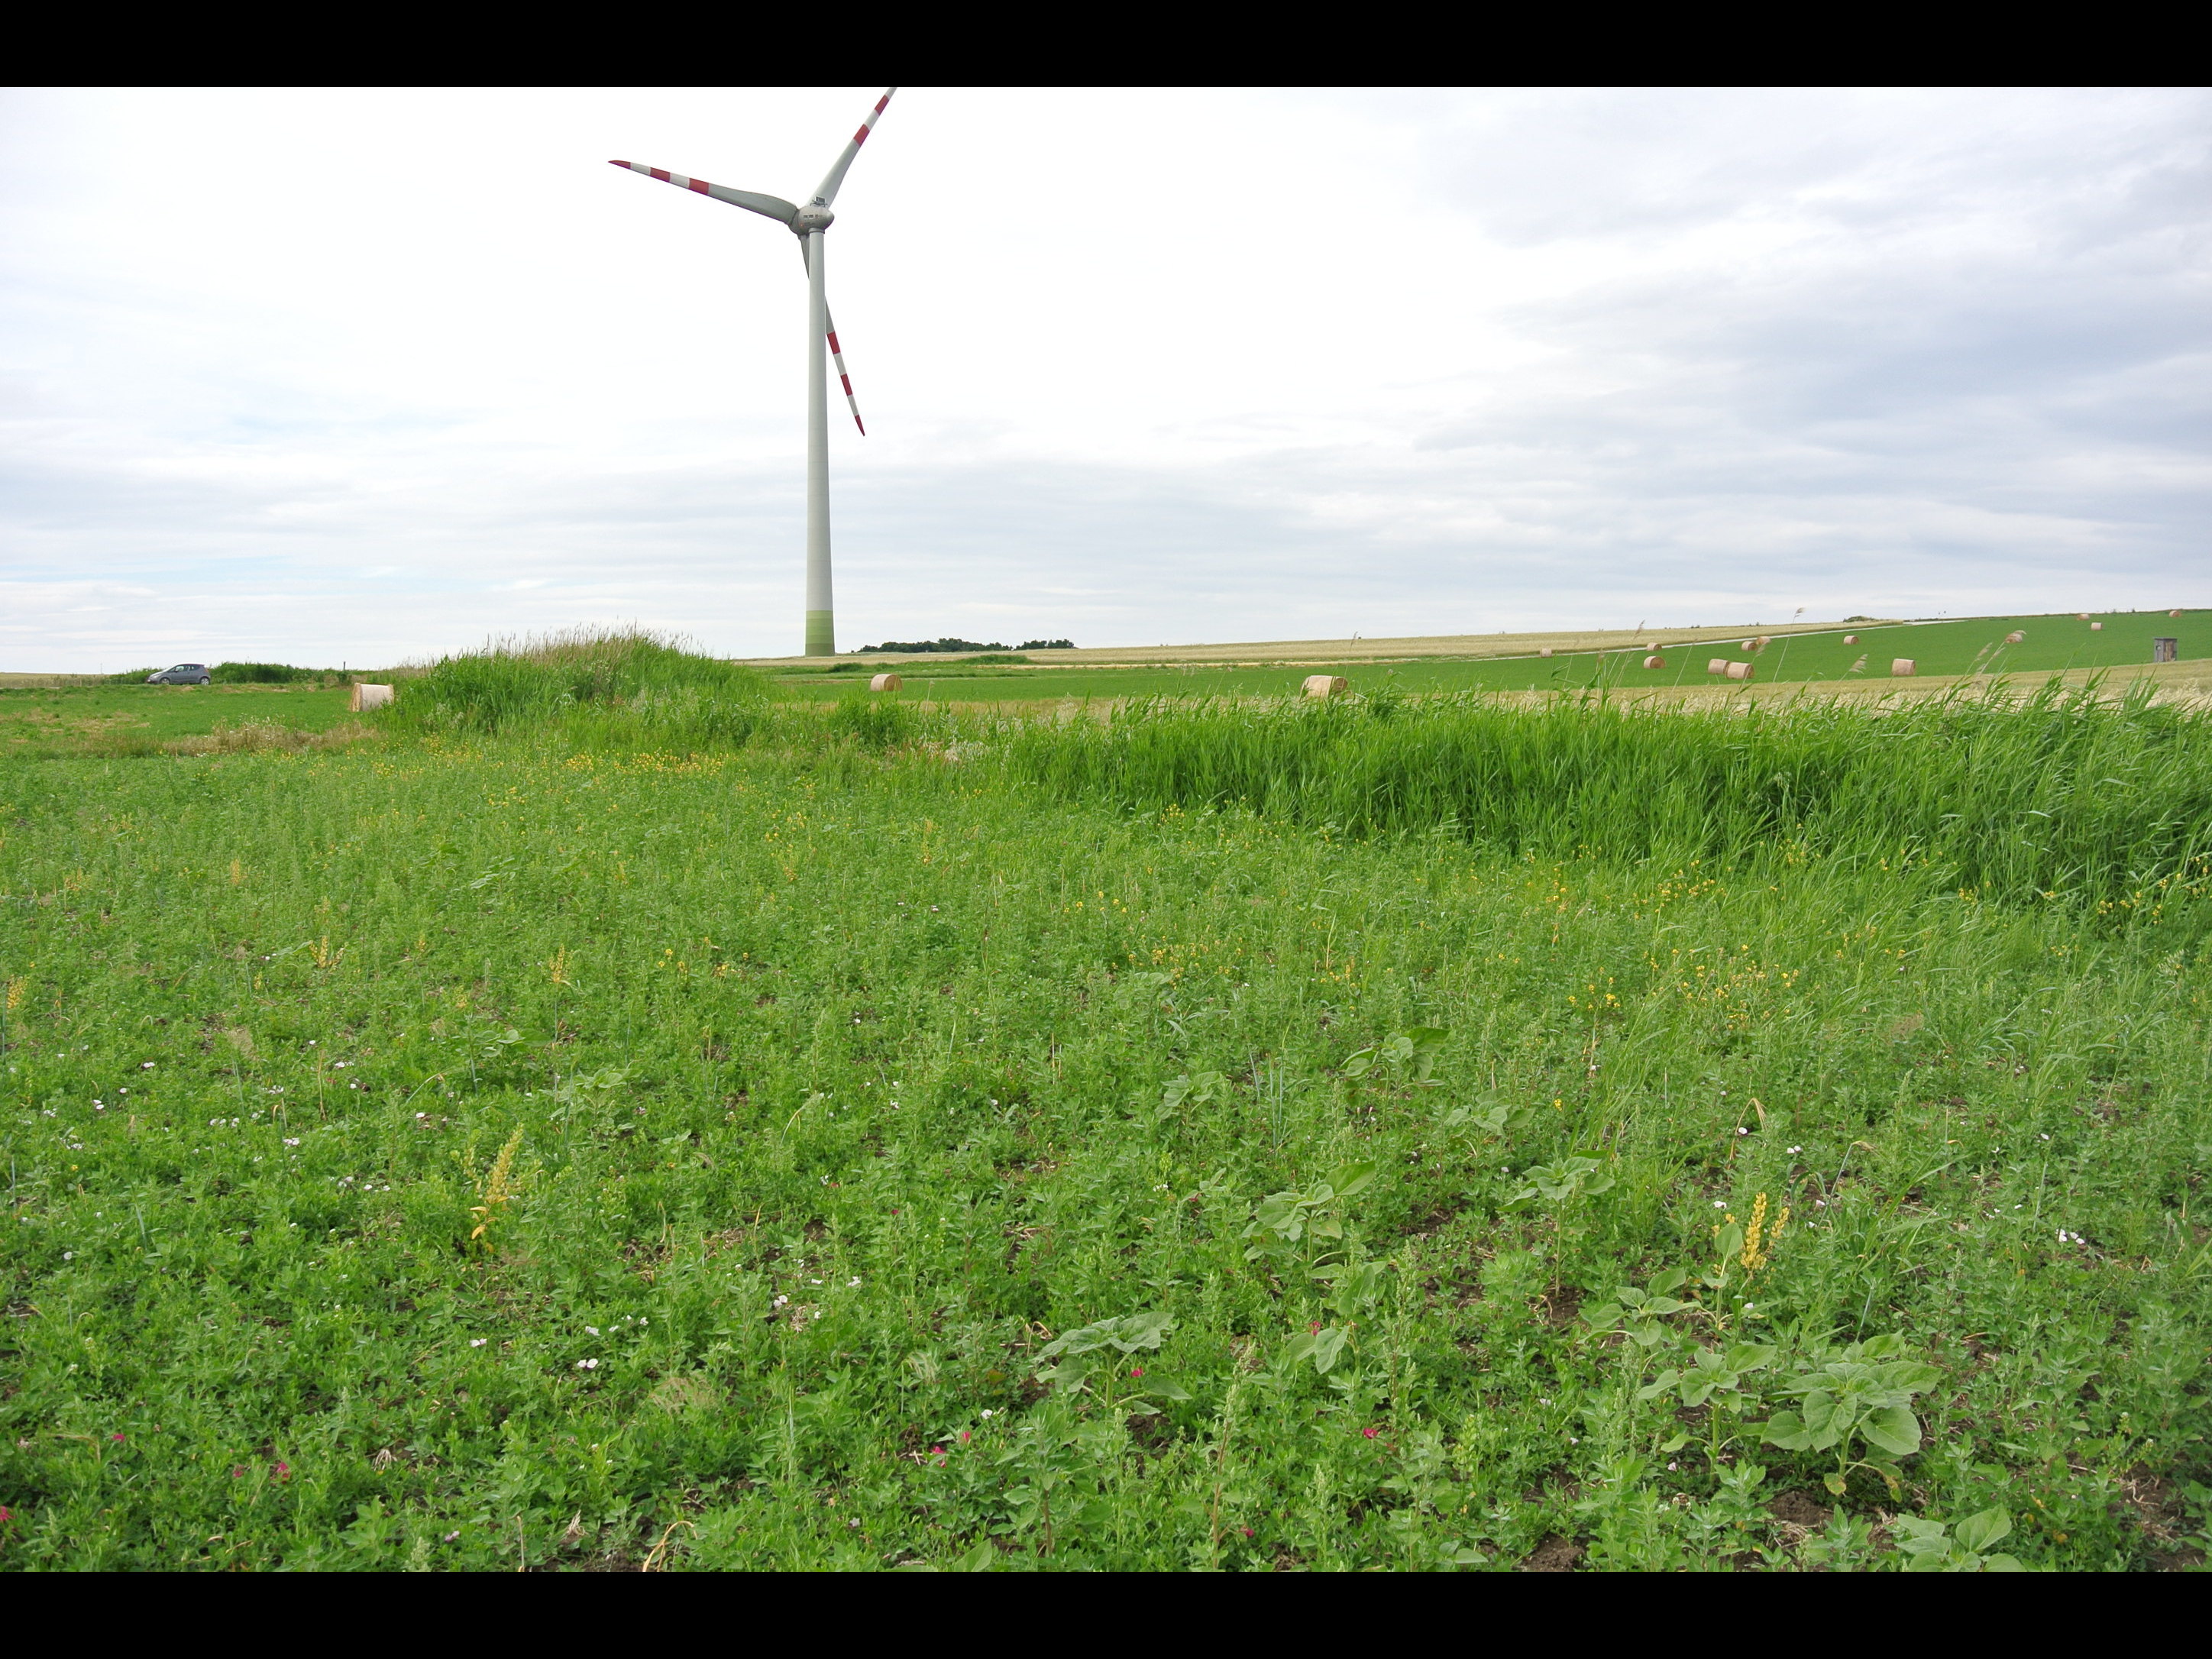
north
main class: Cropland
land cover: Other leguminous and mixtures for fodder
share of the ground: > 75 %
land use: Agriculture (excluding fallow land and kitchen gardens)
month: June
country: AT
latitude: 47.7413
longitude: 16.5259
